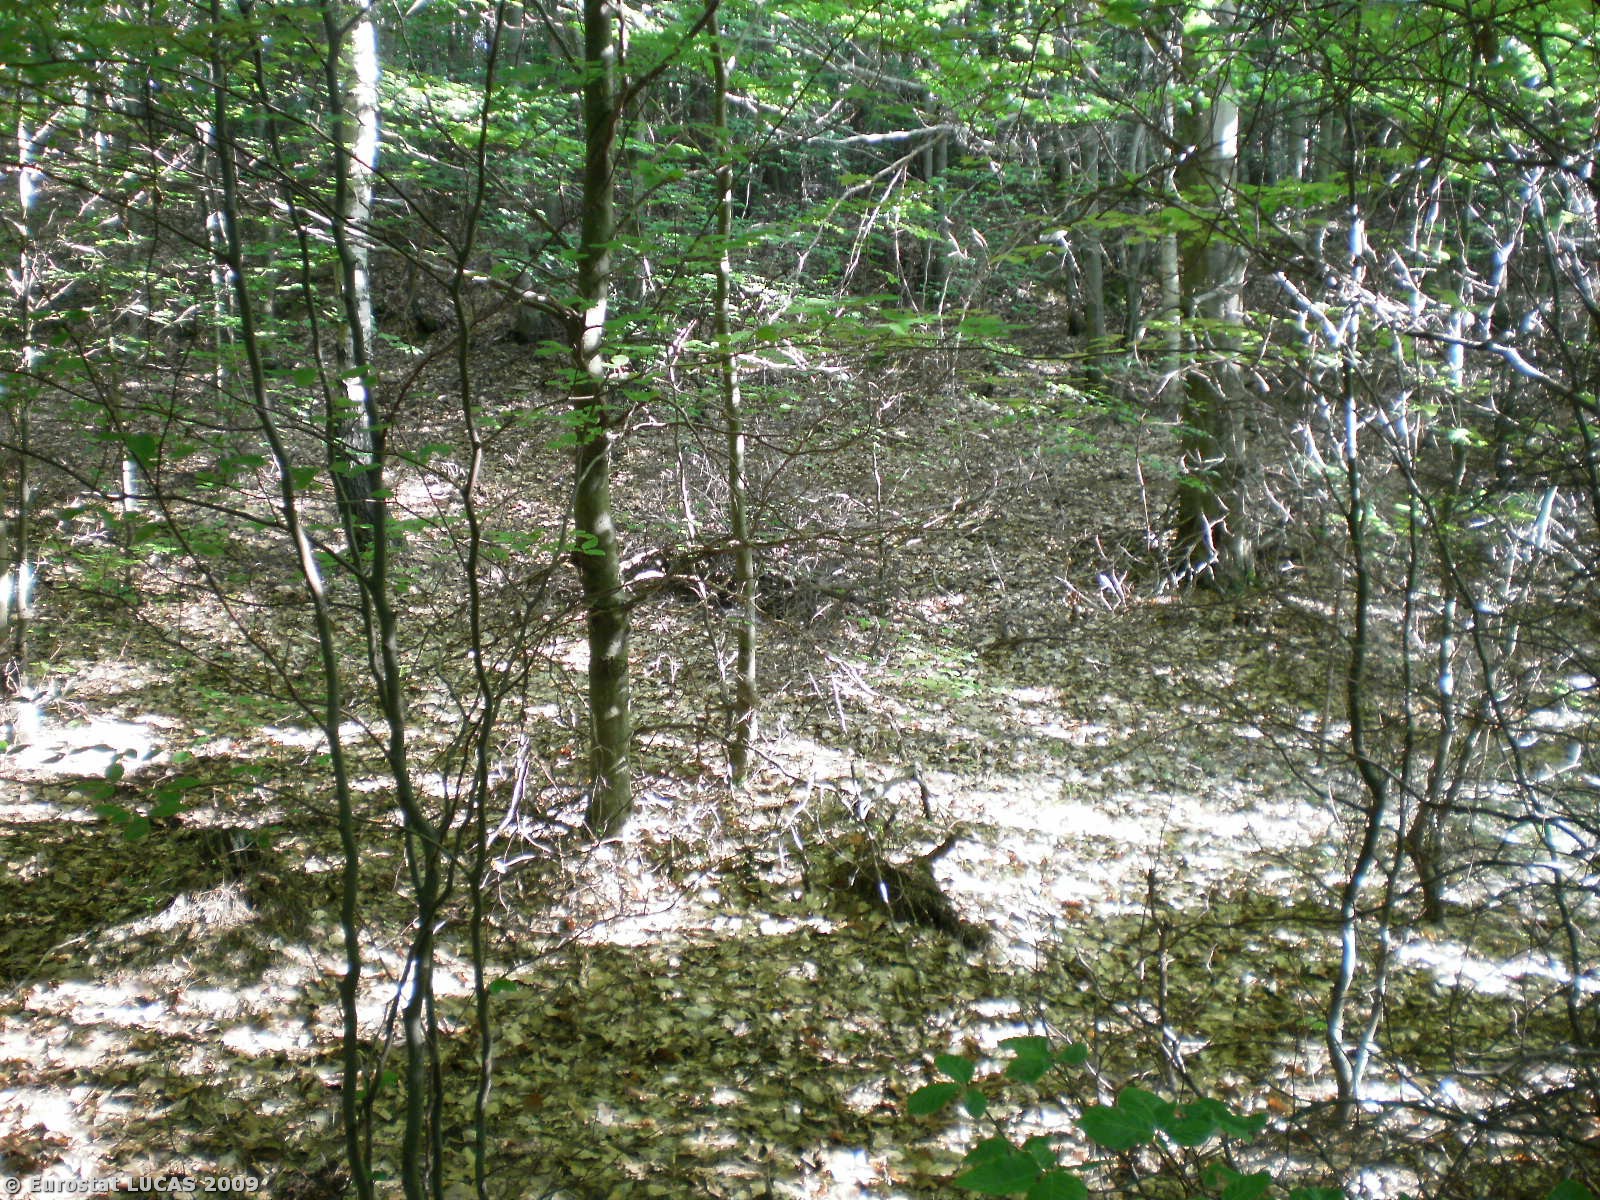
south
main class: Woodland
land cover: Mixed woodland
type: hemiboreal forest and nemoral coniferous forest and mixed broadleaved-coniferous forest
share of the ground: > 75 %
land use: Forestry
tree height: > 5 m
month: July
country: PL
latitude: 54.0719
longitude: 17.7913
